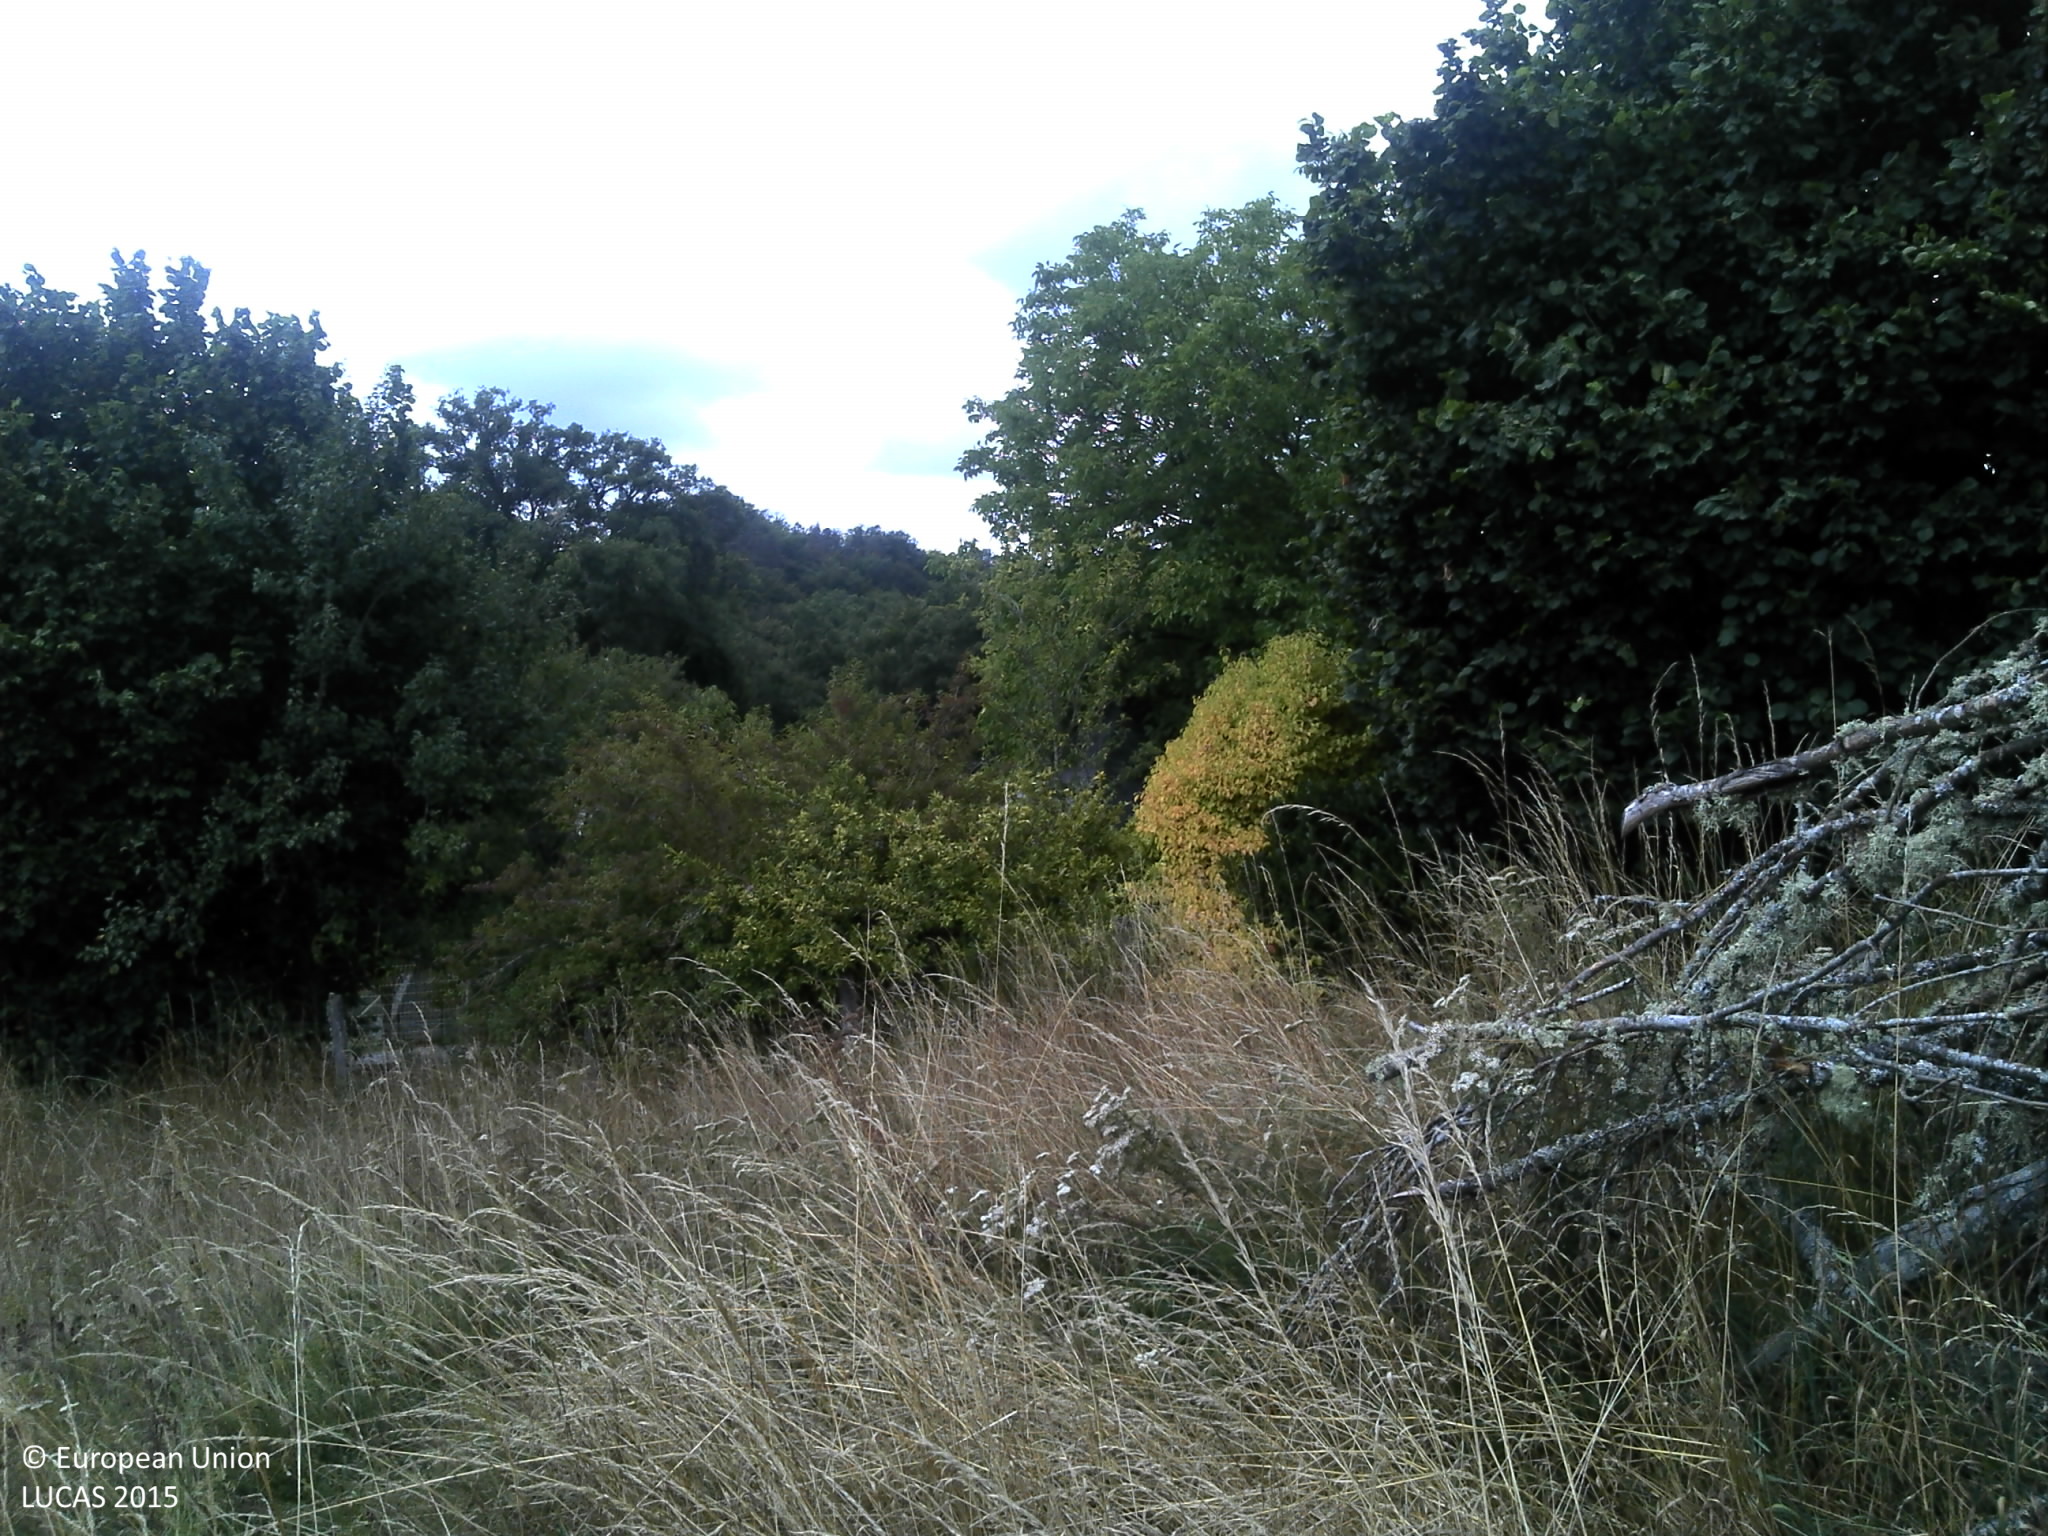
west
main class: Grassland
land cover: Grassland with sparse tree/shrub cover
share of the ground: > 75 %
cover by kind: herbaceous plants 95 %, broadleaved forest trees 5 %
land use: Agriculture (excluding fallow land and kitchen gardens)
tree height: > 5 m
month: August
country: FR
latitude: 45.5487
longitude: 2.2994
